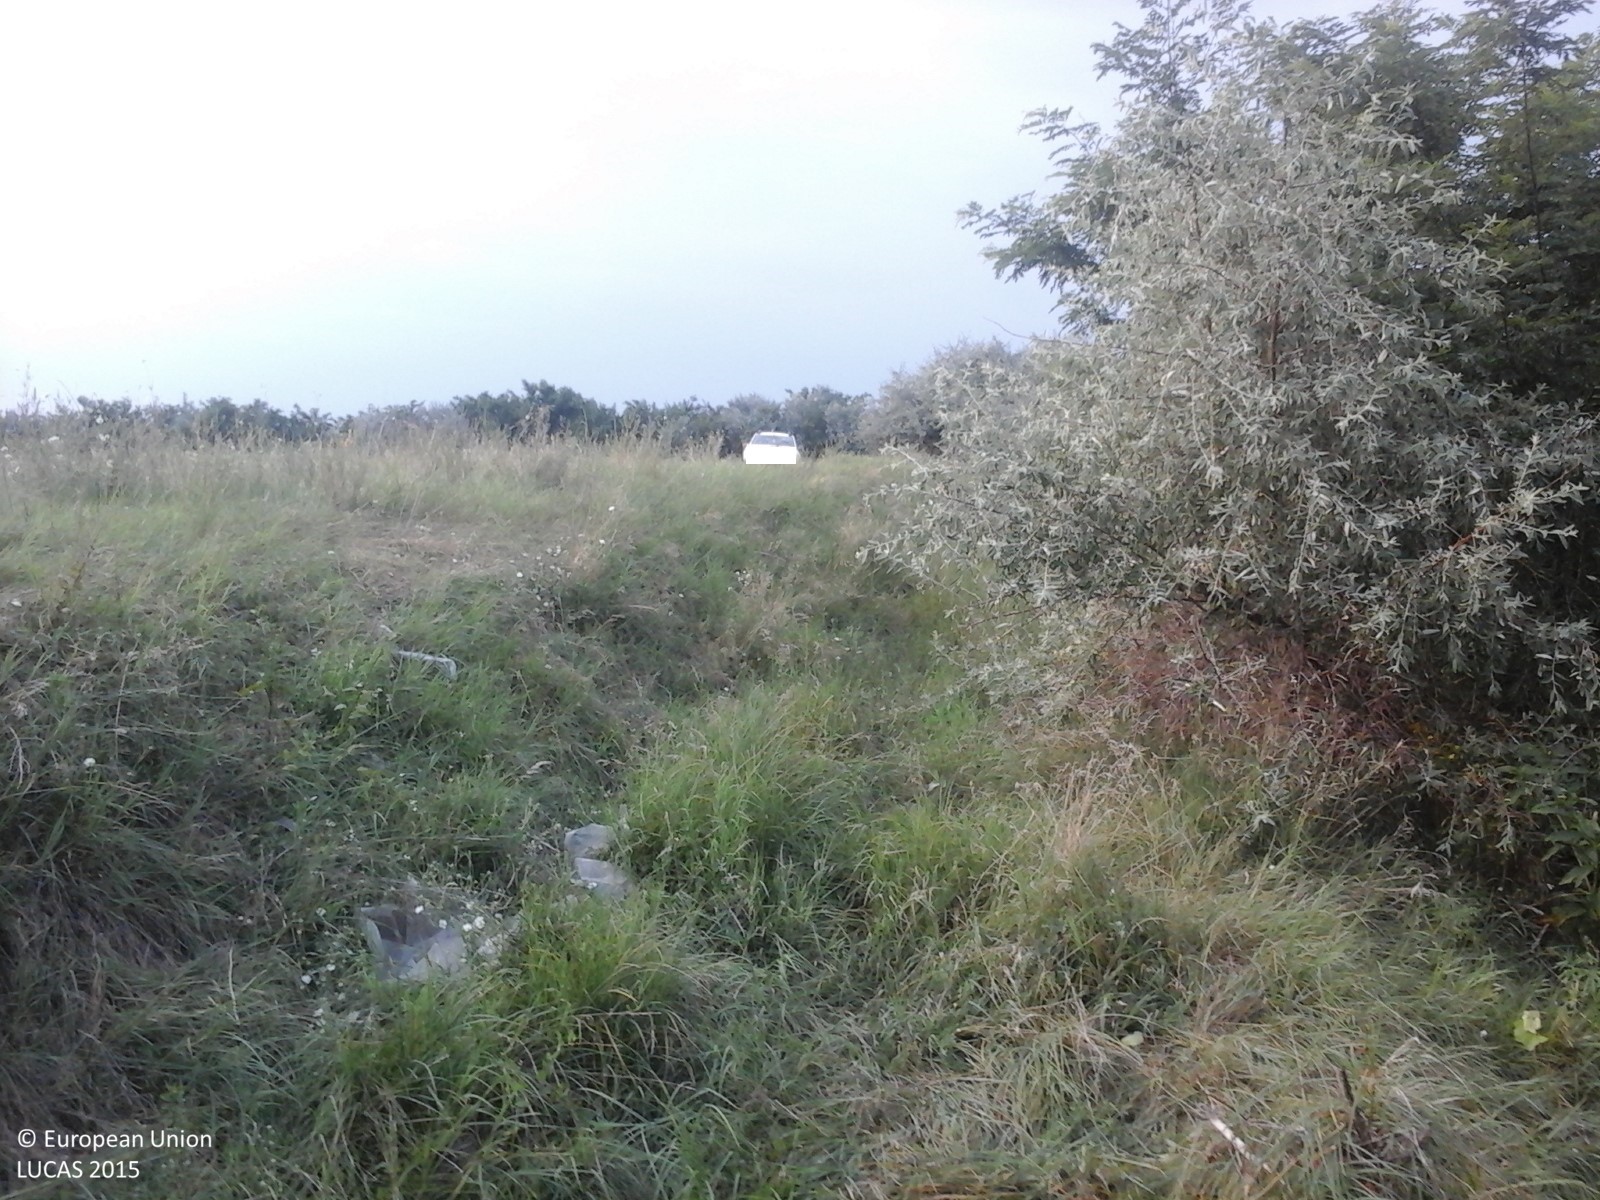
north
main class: Grassland
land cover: Spontaneously vegetated surfaces
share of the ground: > 75 %
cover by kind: herbaceous plants 100 %
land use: Agriculture (excluding fallow land and kitchen gardens)
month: July
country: RO
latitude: 43.8150
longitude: 24.1441
